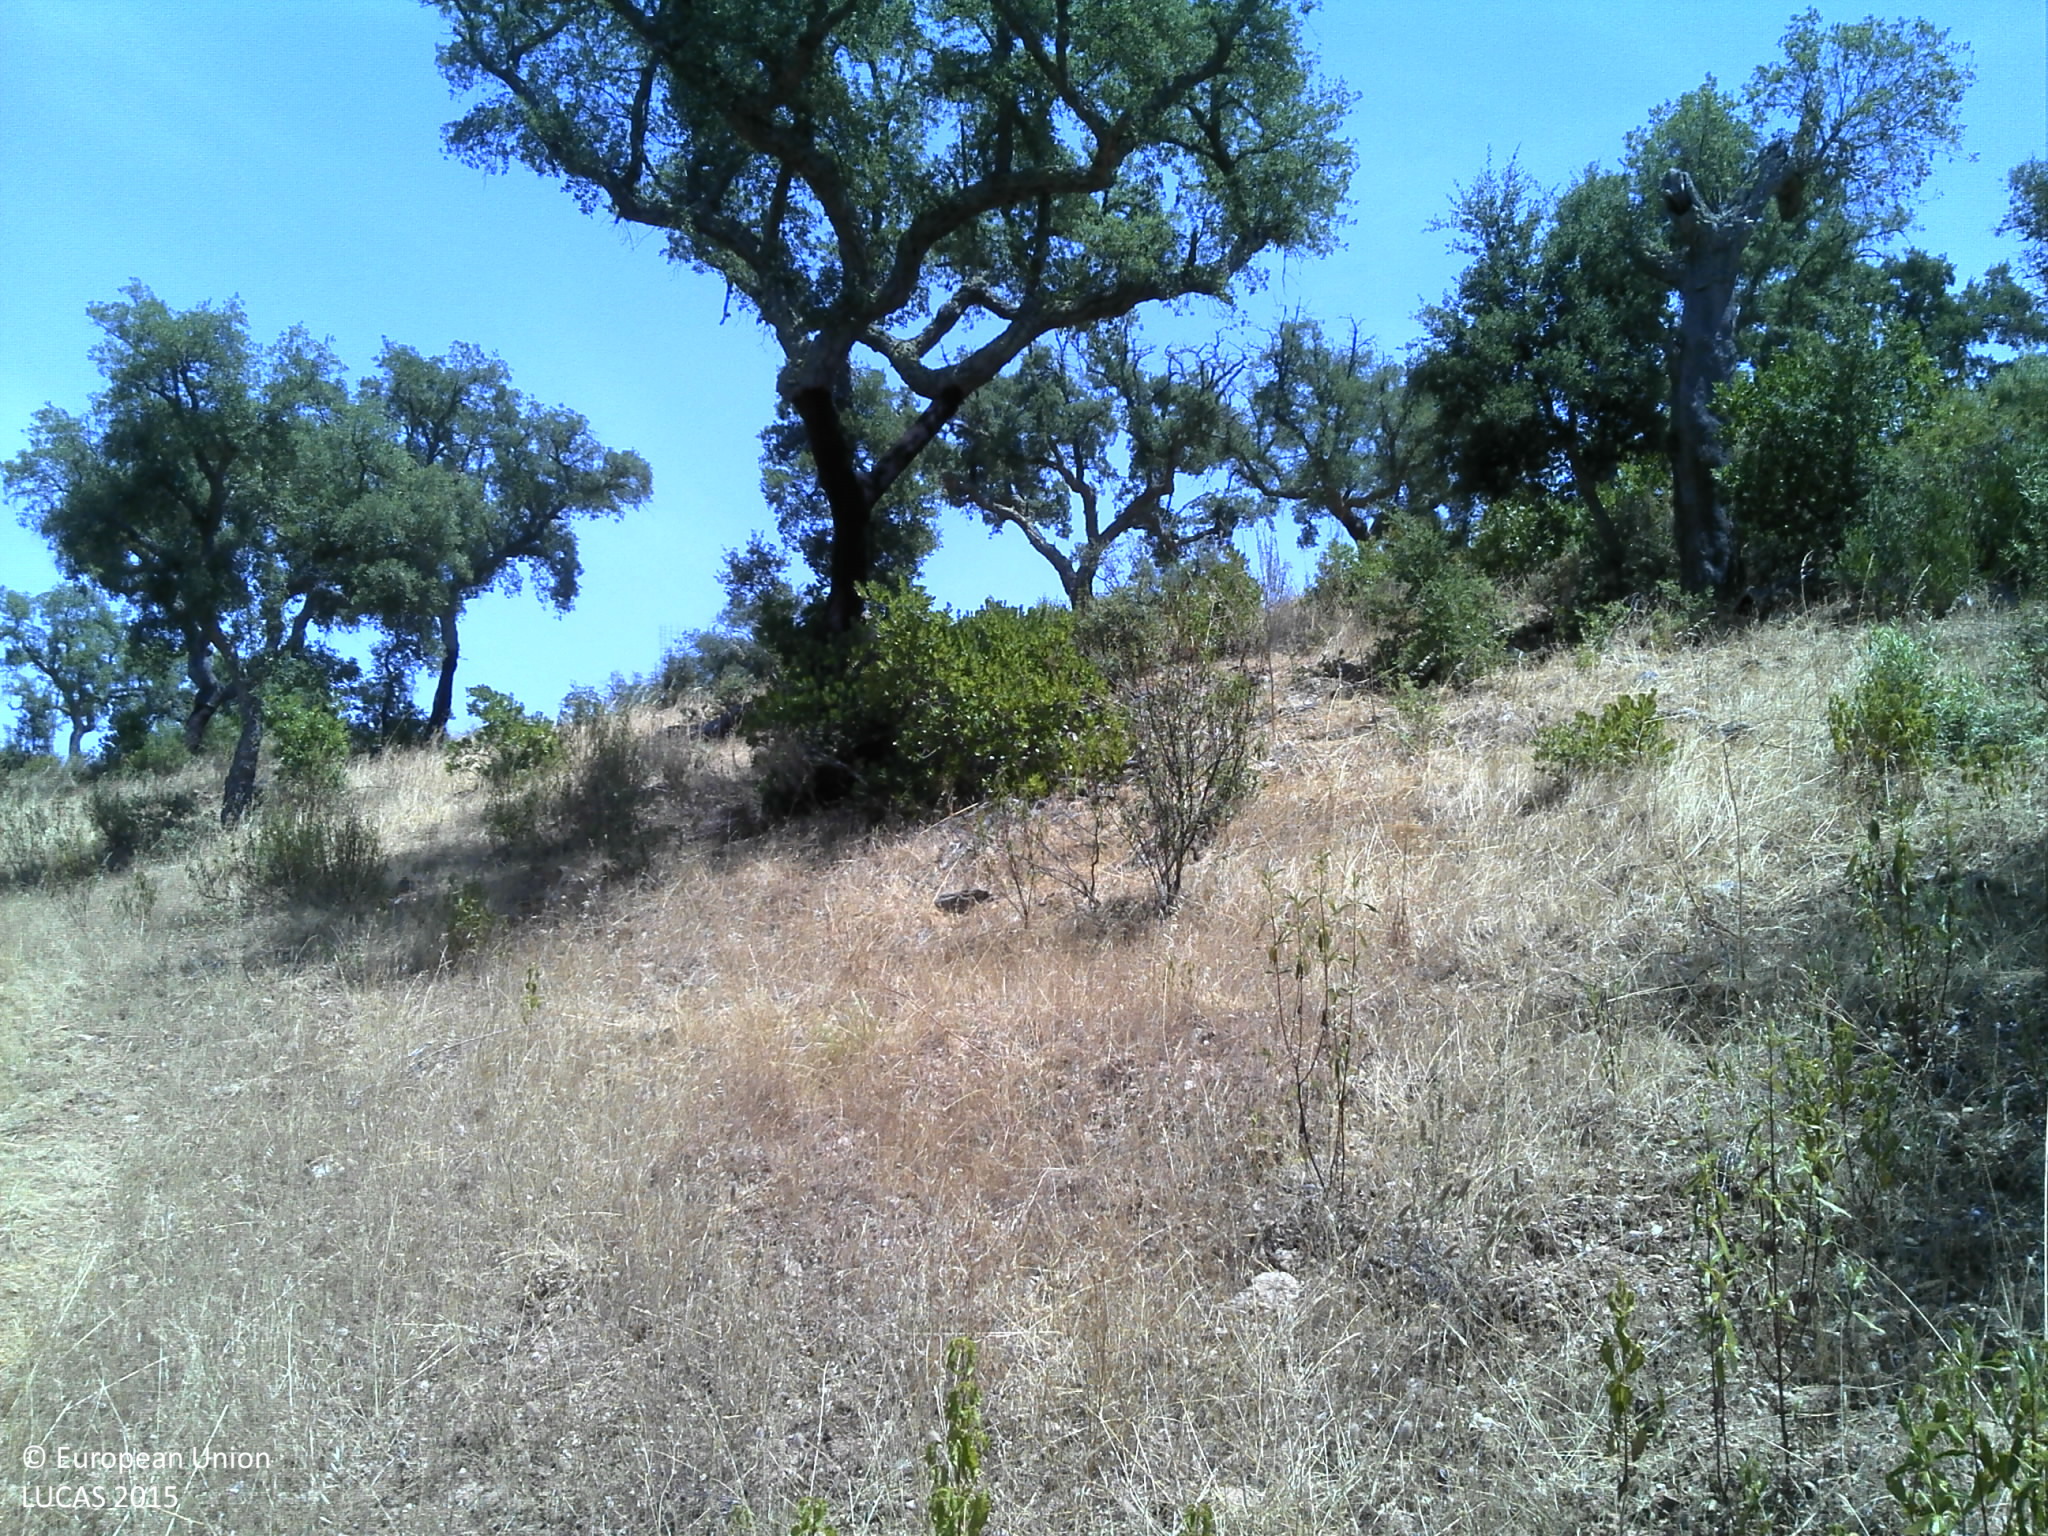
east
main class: Woodland
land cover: Broadleaved woodland
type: broadleaved evergreen forest
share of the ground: 25 - 50 %
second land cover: Shrubland without tree cover
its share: 25 - 50 %
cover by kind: unconsolidated bare surface 40 %, broadleaved forest trees 25 %, shrubs 25 %, herbaceous plants 10 %
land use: Forestry
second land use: Agriculture (excluding fallow land and kitchen gardens)
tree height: > 5 m
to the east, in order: Broadleaved woodland; Shrubland without tree cover; Broadleaved woodland; Rivers and streams; Shrubland without tree cover; Broadleaved woodland; Shrubland without tree cover; Broadleaved woodland
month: July
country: PT
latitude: 38.2573
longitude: -7.5910
